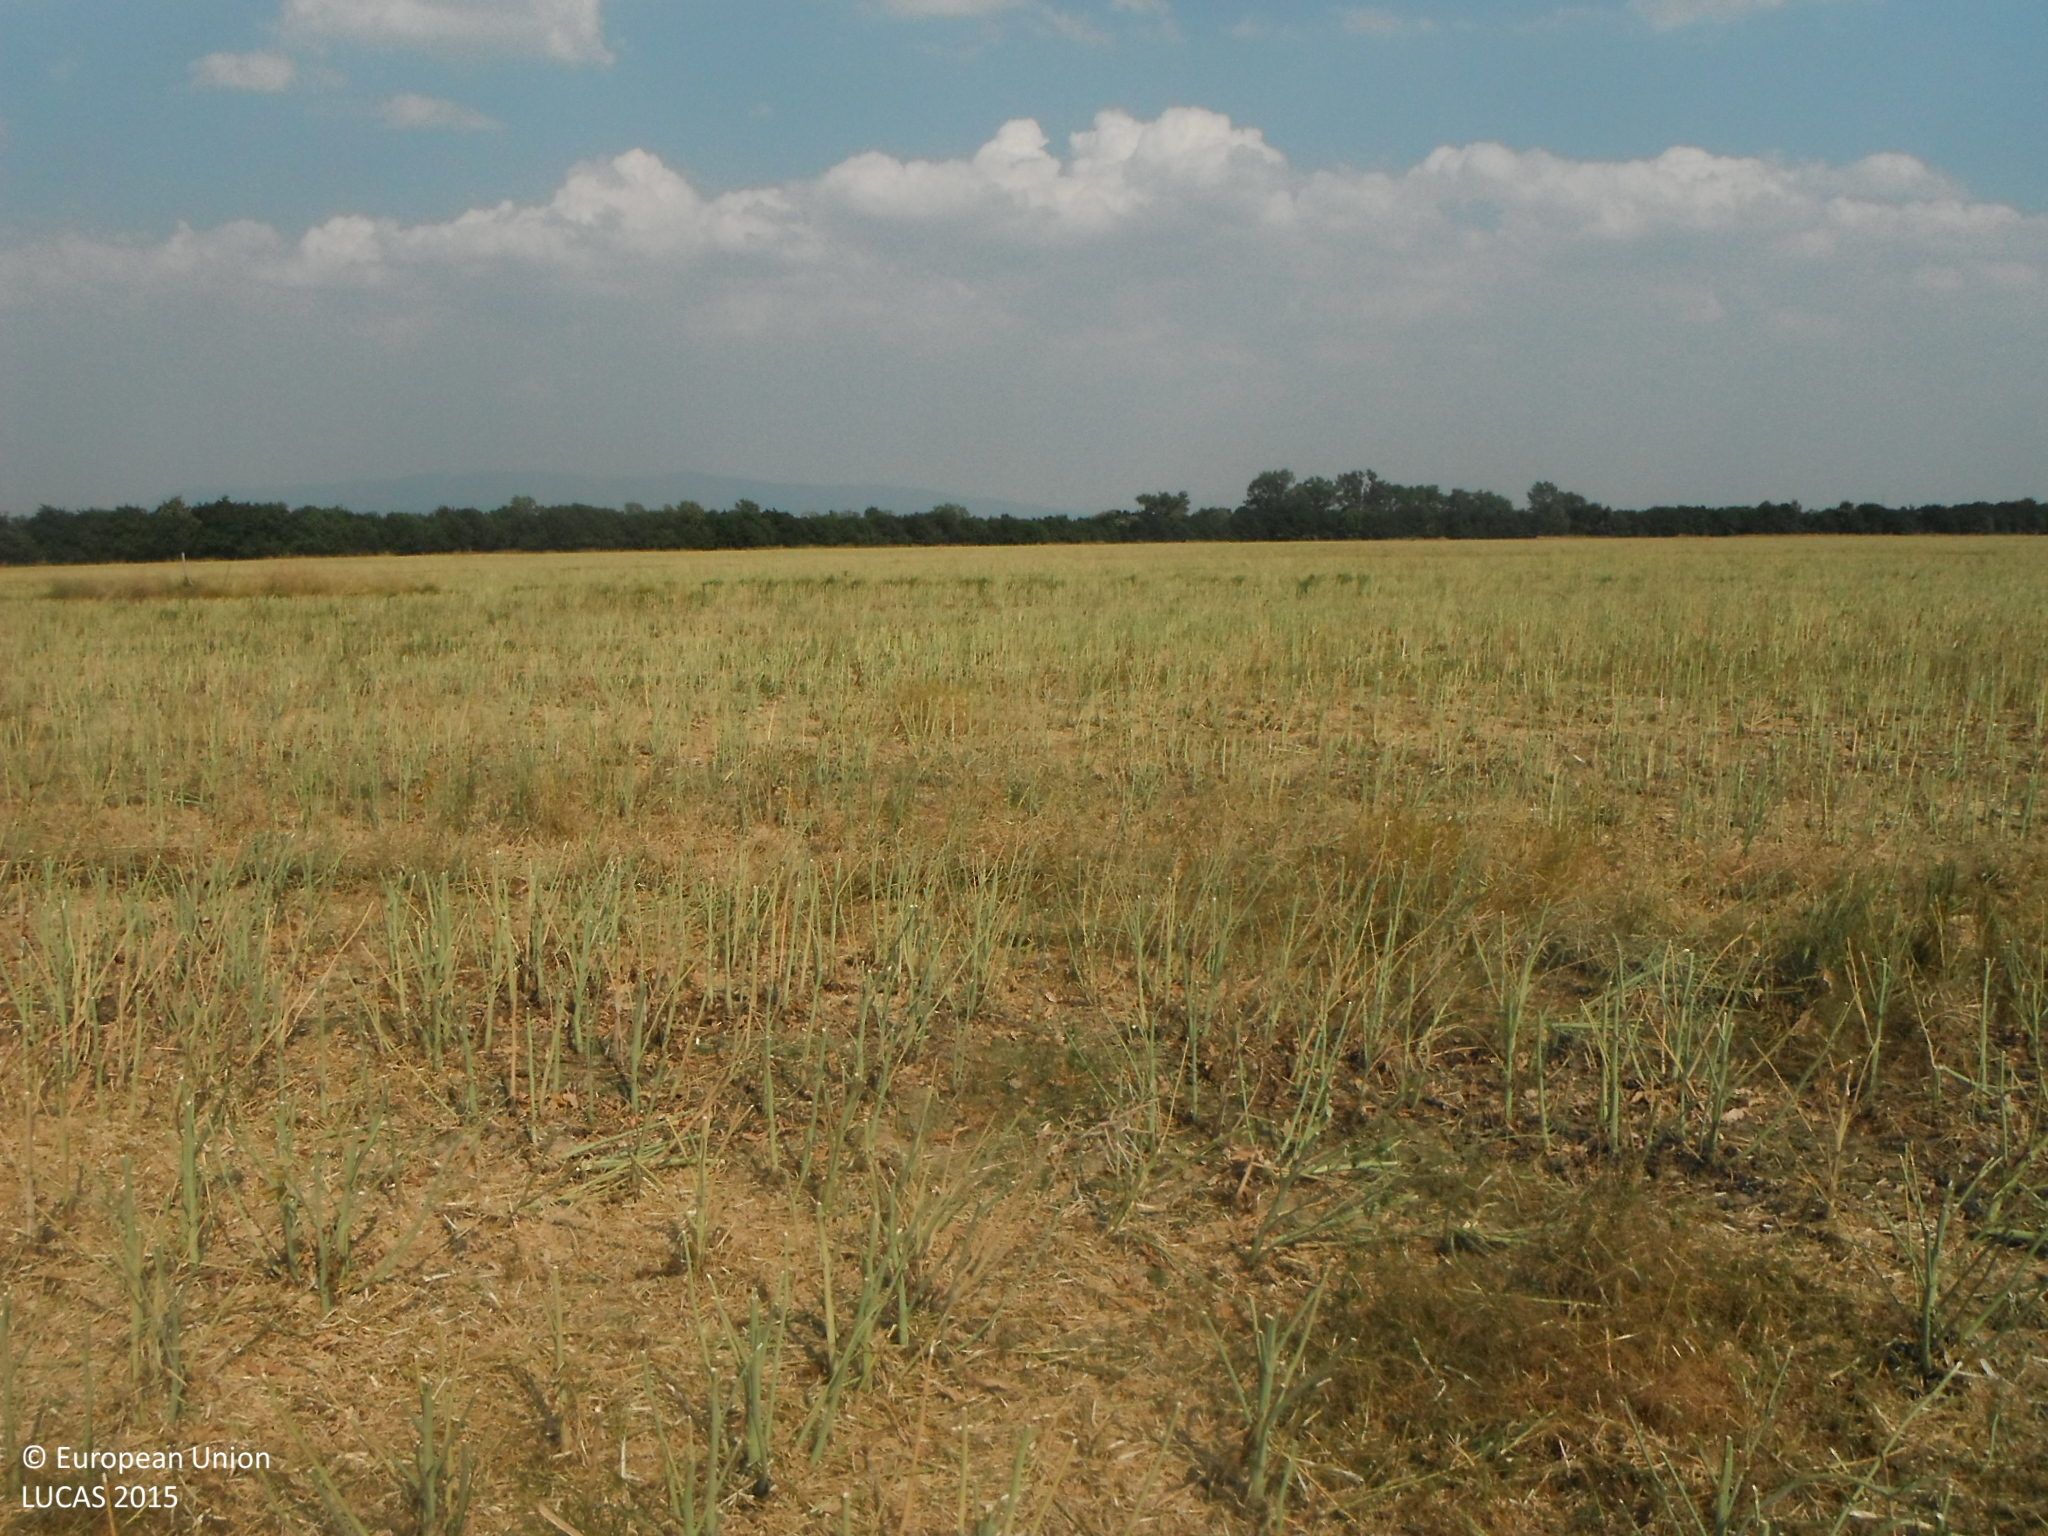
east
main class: Cropland
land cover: Rape and turnip rape
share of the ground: > 75 %
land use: Agriculture (excluding fallow land and kitchen gardens)
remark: Harvested field
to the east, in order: Rape and turnip rape
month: July
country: SK
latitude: 48.7378
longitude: 22.0899
